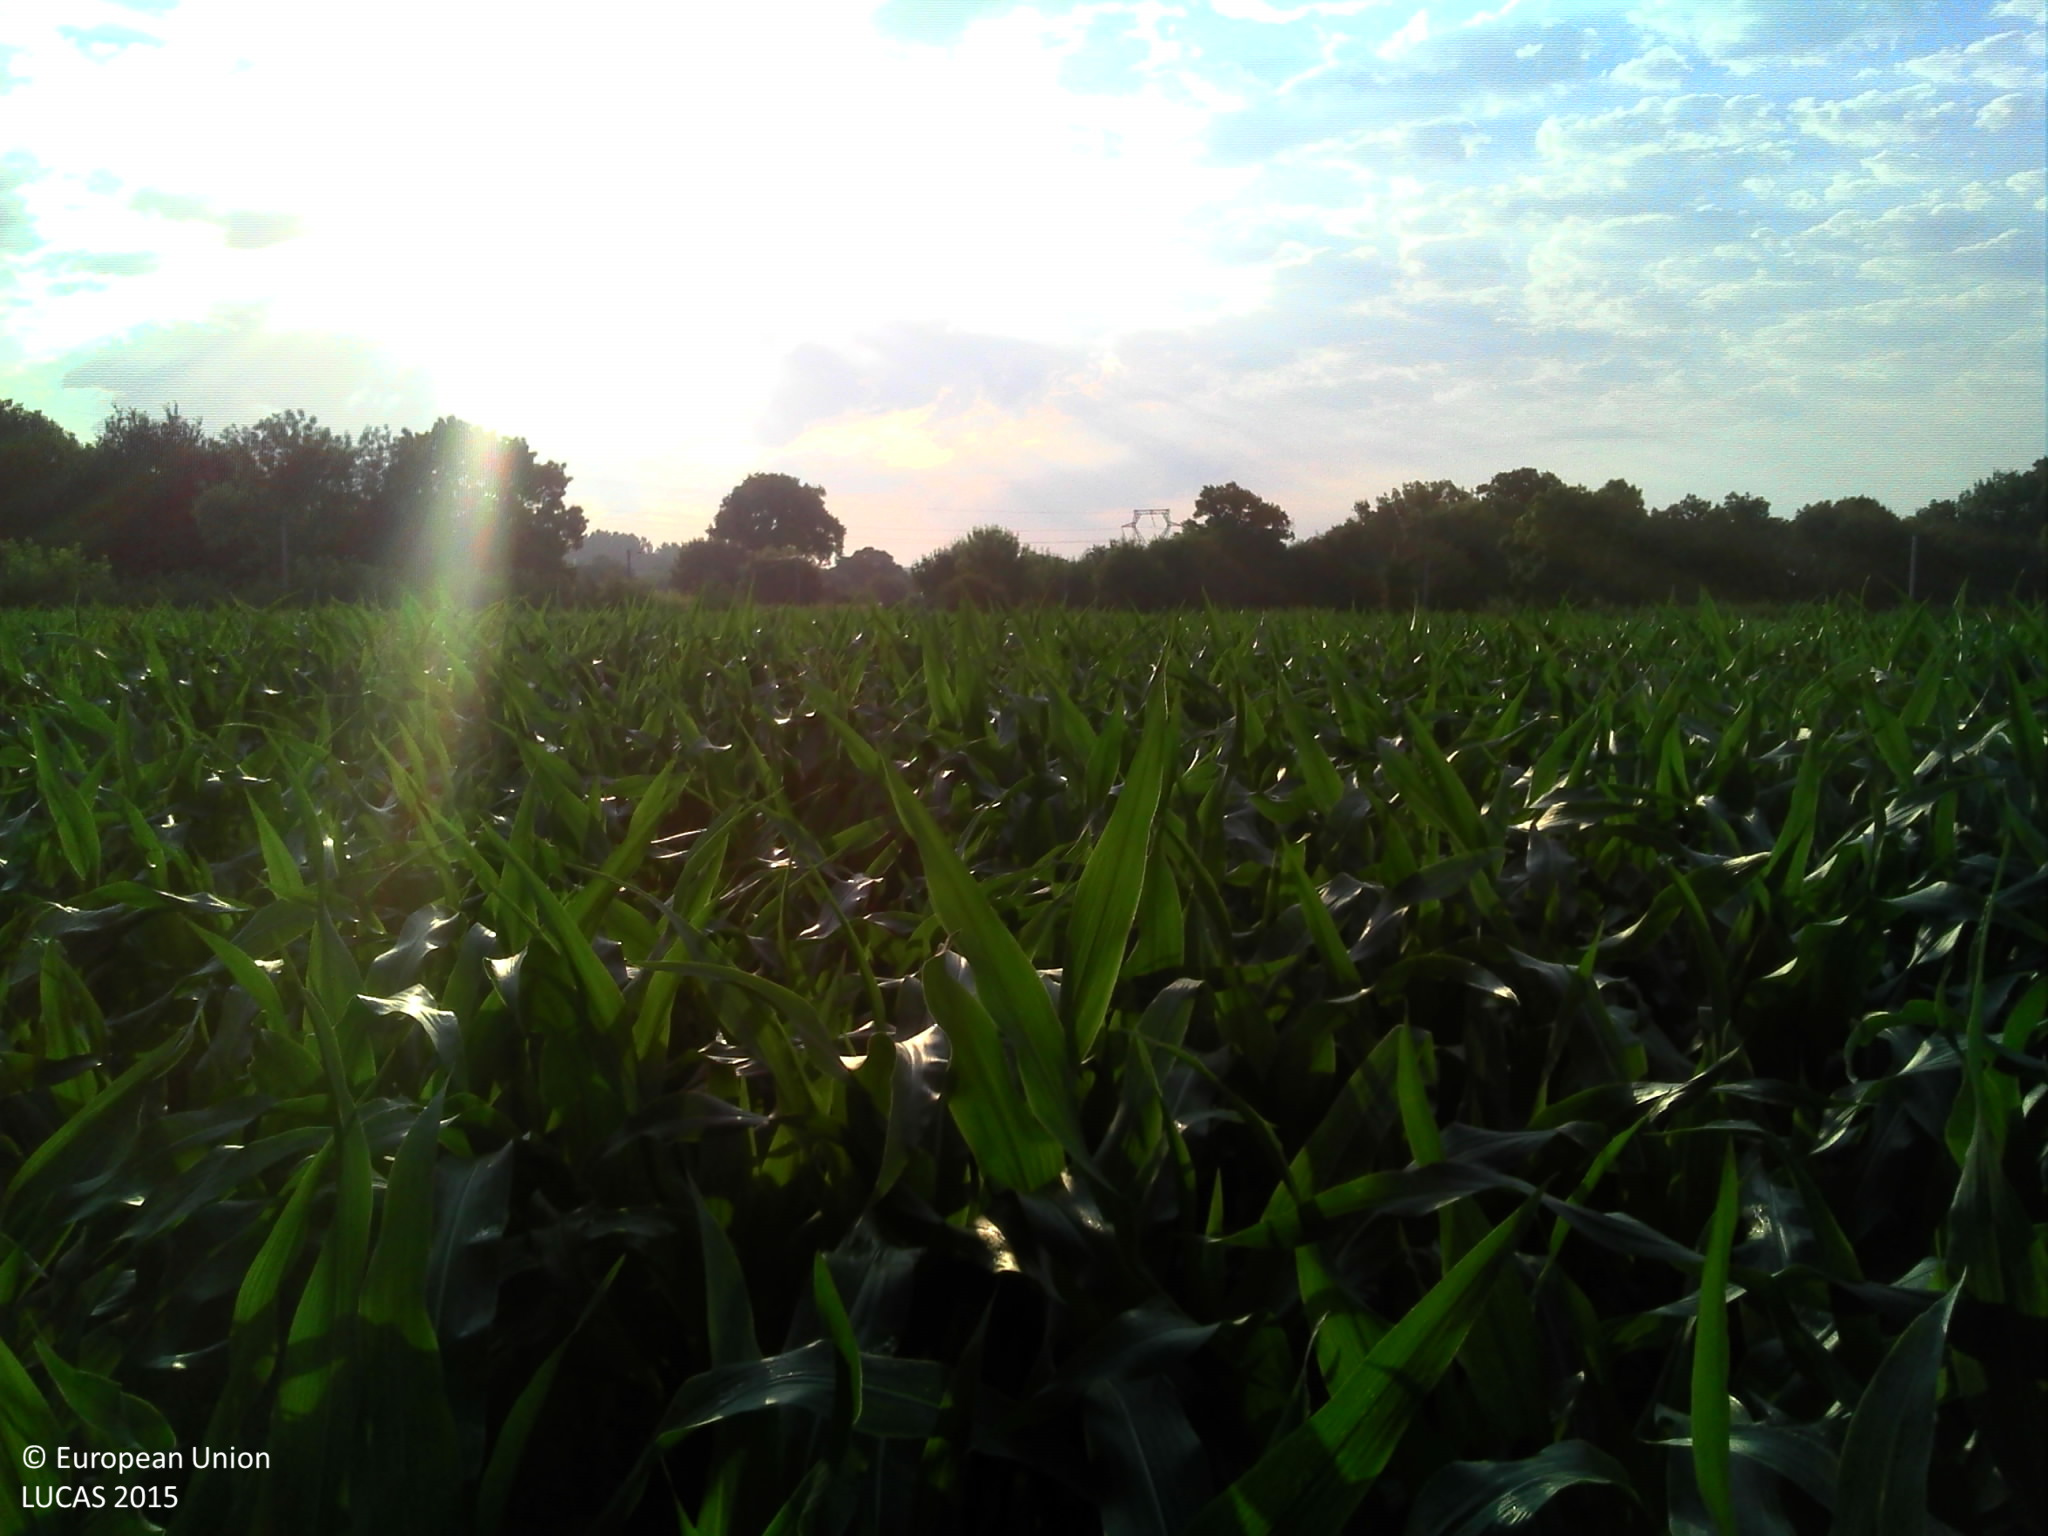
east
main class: Cropland
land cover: Maize
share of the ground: > 75 %
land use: Agriculture (excluding fallow land and kitchen gardens)
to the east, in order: Maize; Fences; Managed hedges; Electric lines; Ditches and canals; Grass margins; Paved roads, cycling and walking lanes; Grass margins; Ditches and canals; Managed hedges; Grassland without tree/shrub cover; Broadleaved woodland; Ditches and canals; Broadleaved woodland; Grassland without tree/shrub cover
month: July
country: FR
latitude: 47.2457
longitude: -1.7638
